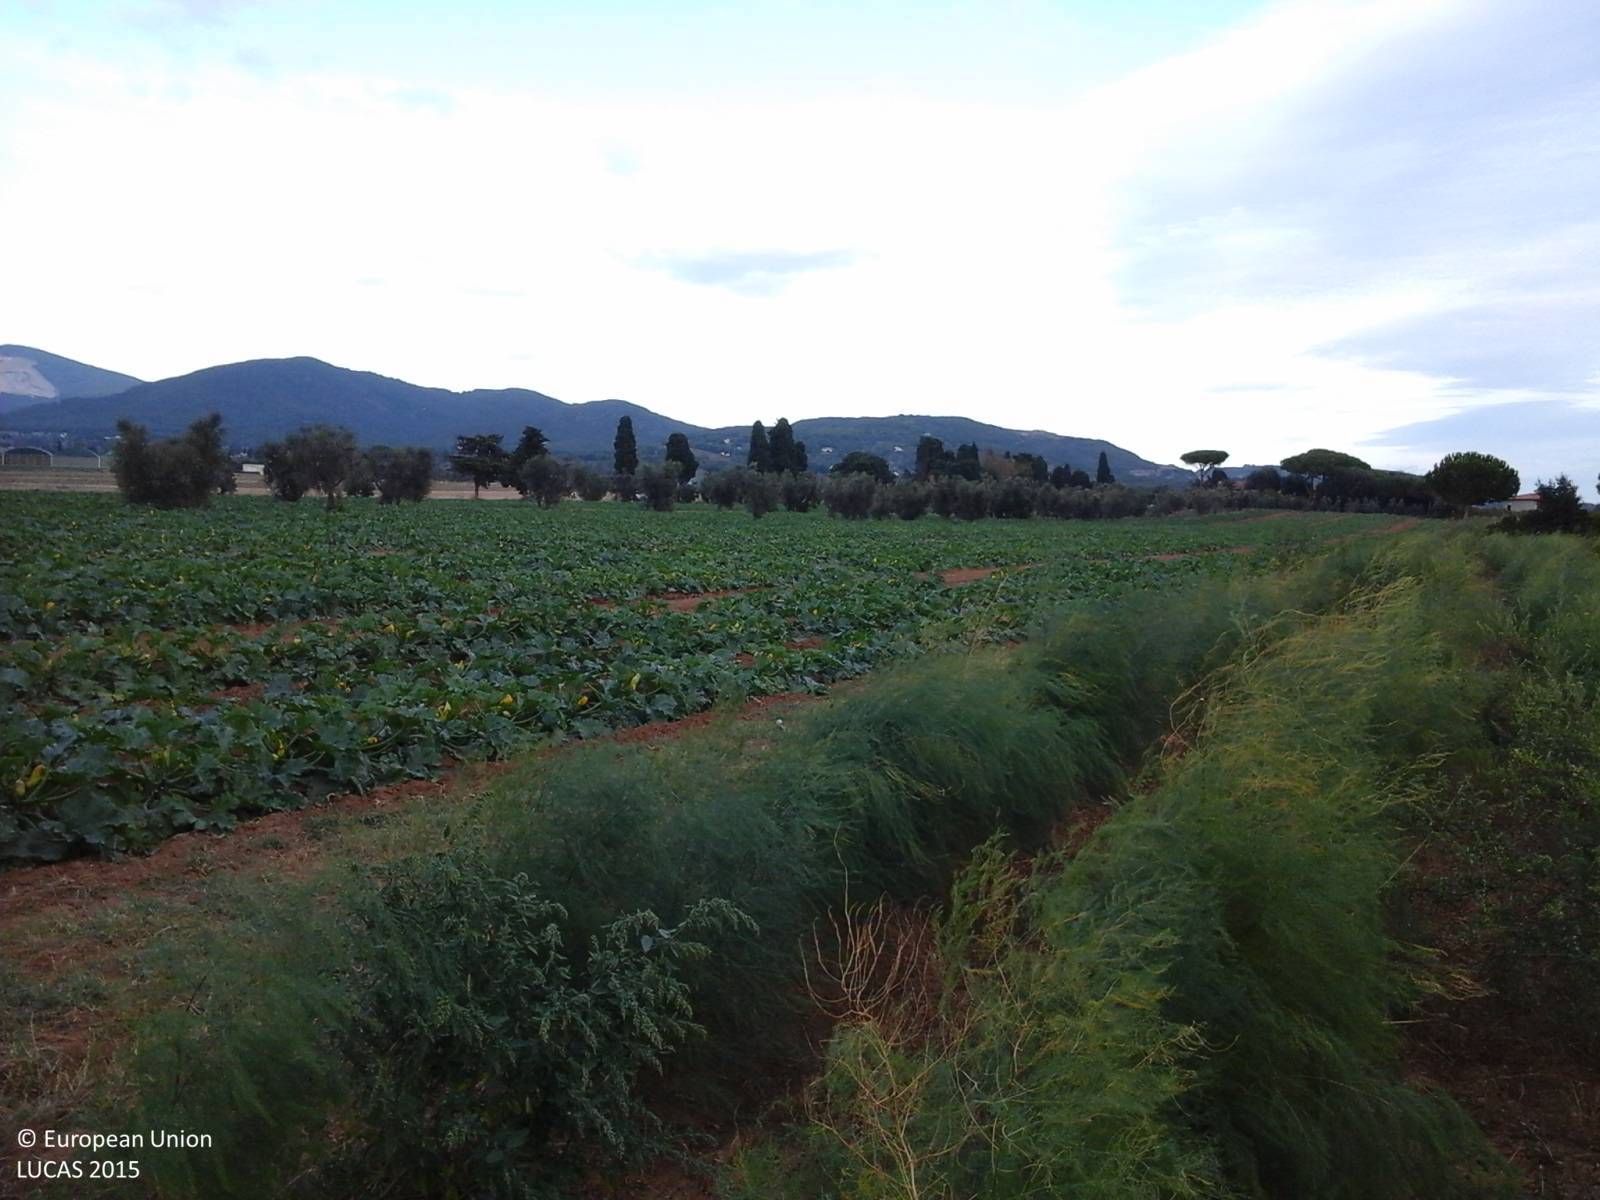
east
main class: Cropland
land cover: Other non-permanent industrial crops
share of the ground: 25 - 50 %
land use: Agriculture (excluding fallow land and kitchen gardens)
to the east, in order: Other non-permanent industrial crops; Grass margins; Ditches and canals; Other non-permanent industrial crops; Olive groves; Other non-permanent industrial crops; Olive groves
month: September
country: IT
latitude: 43.0498
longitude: 10.5507
